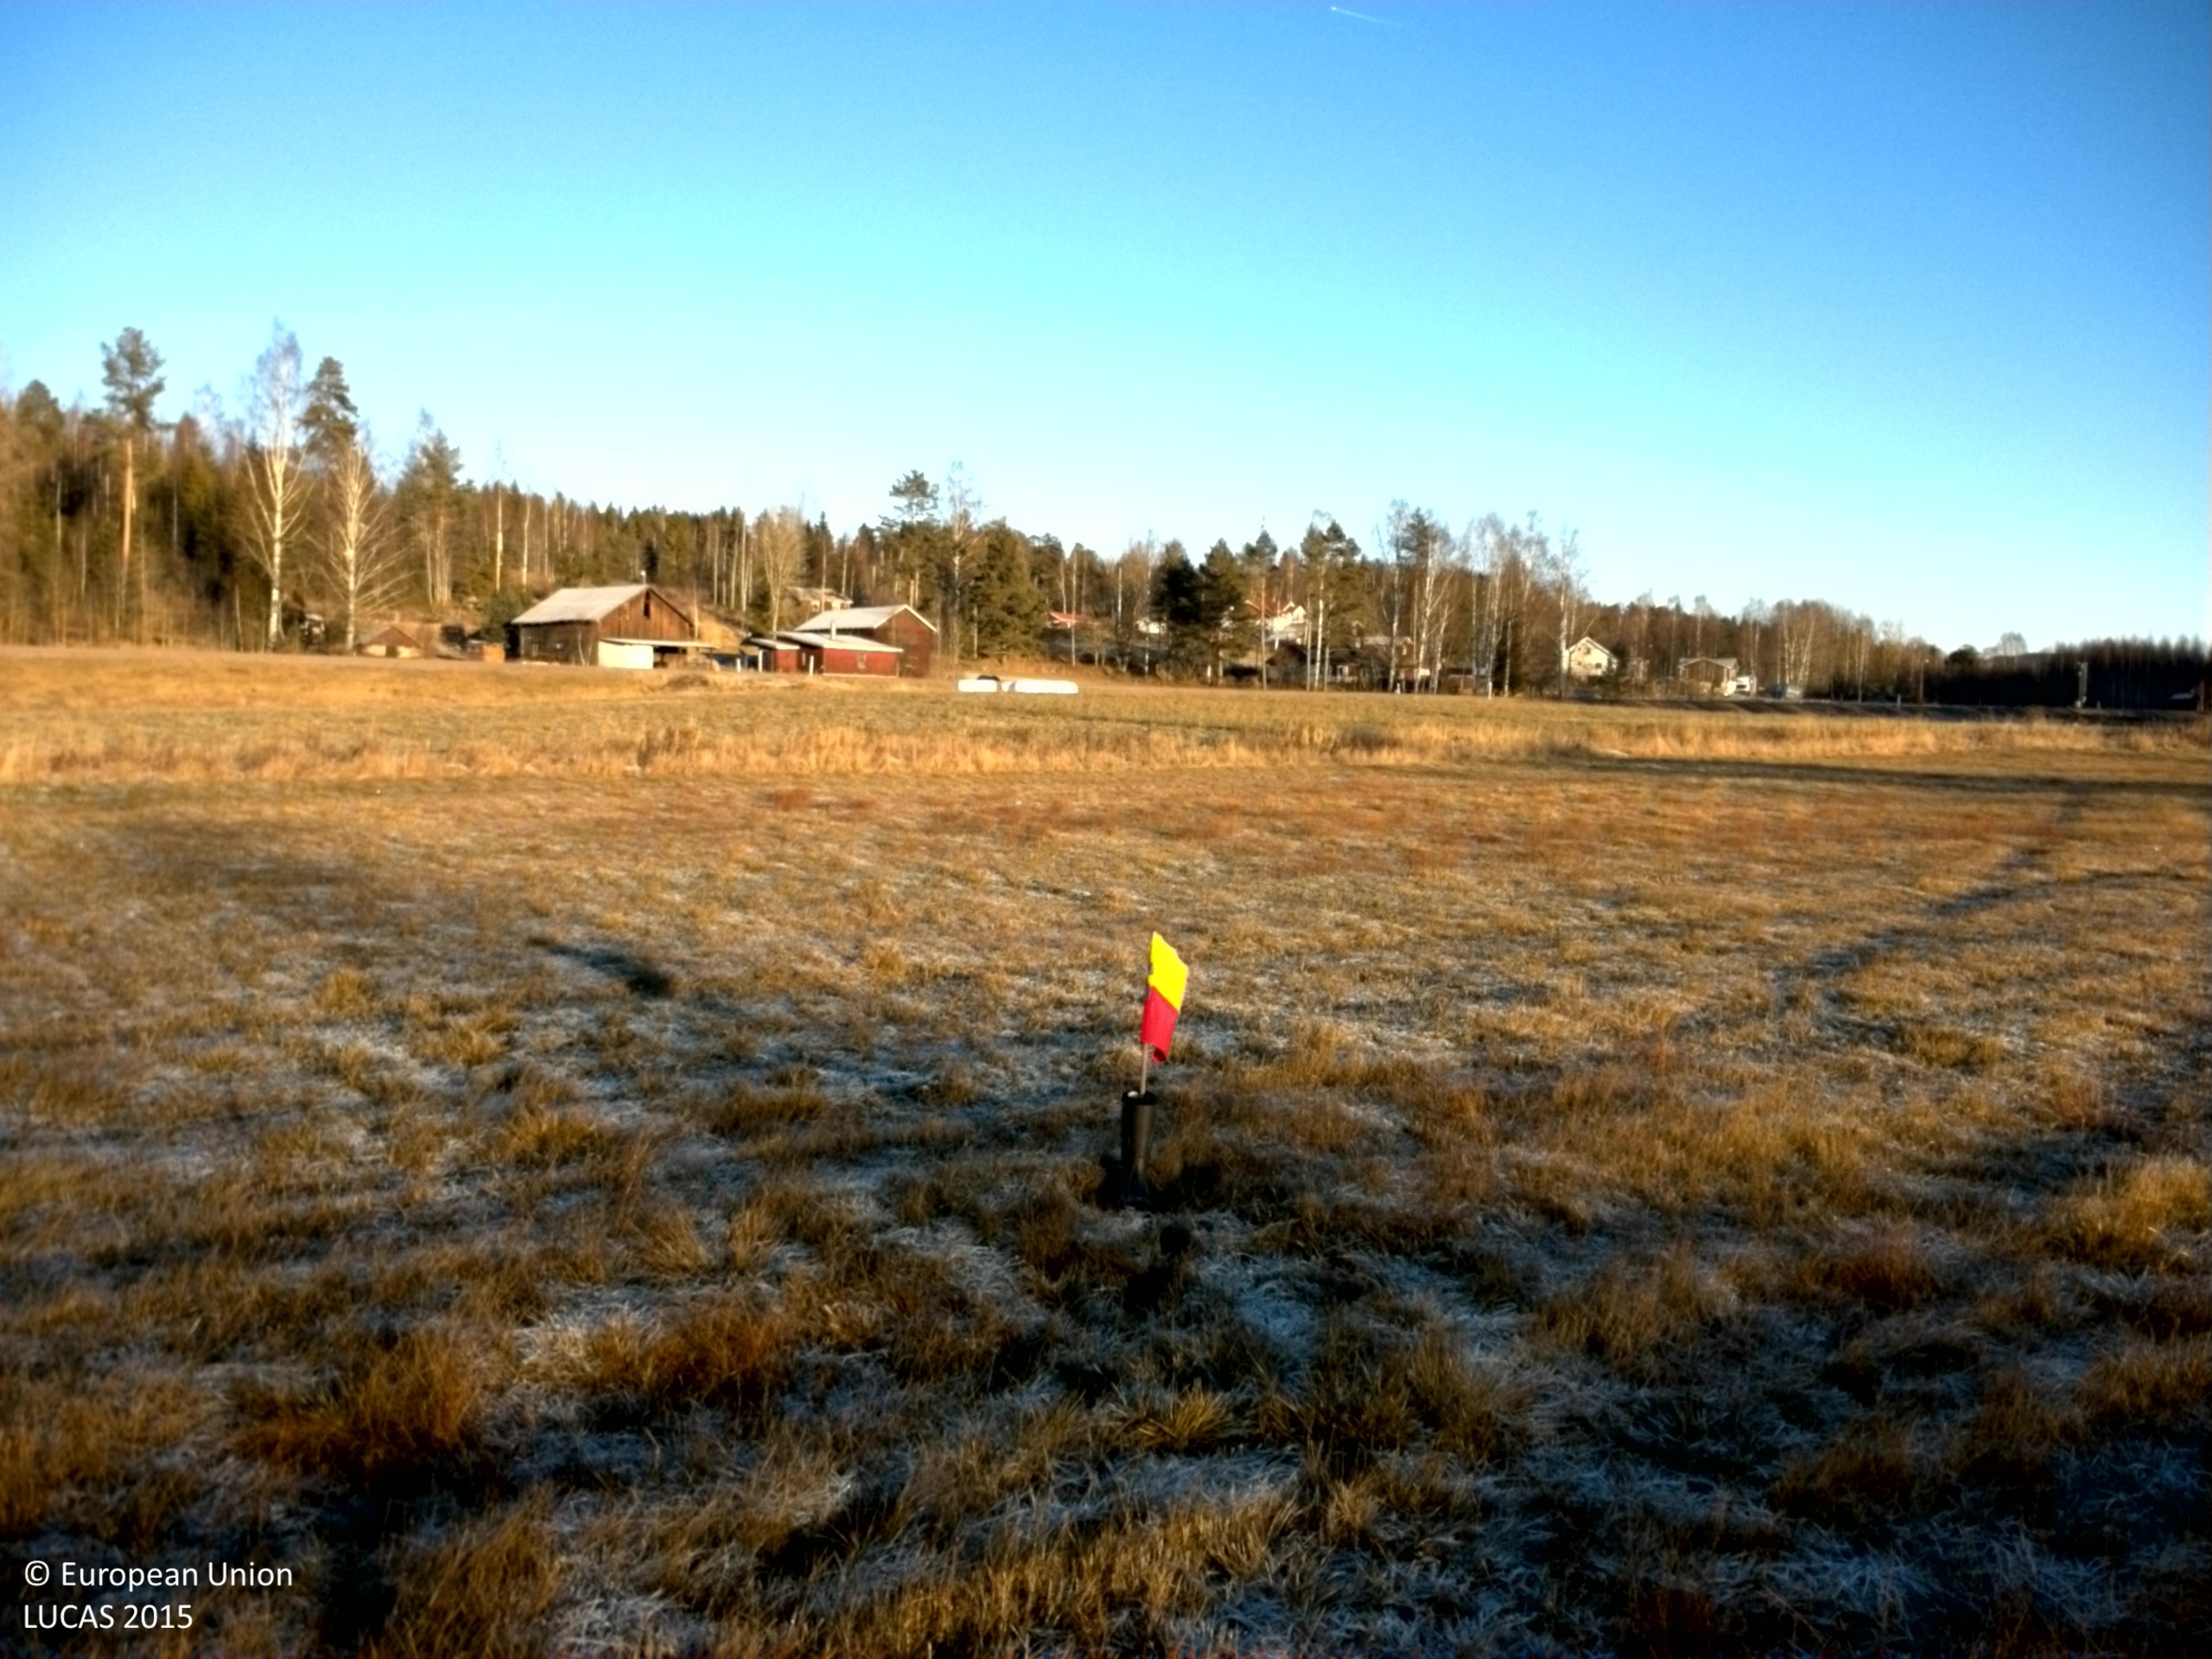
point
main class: Cropland
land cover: Mixed cereals for fodder
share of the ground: > 75 %
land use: Agriculture (excluding fallow land and kitchen gardens)
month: November
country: SE
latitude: 61.8159
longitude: 16.1887
